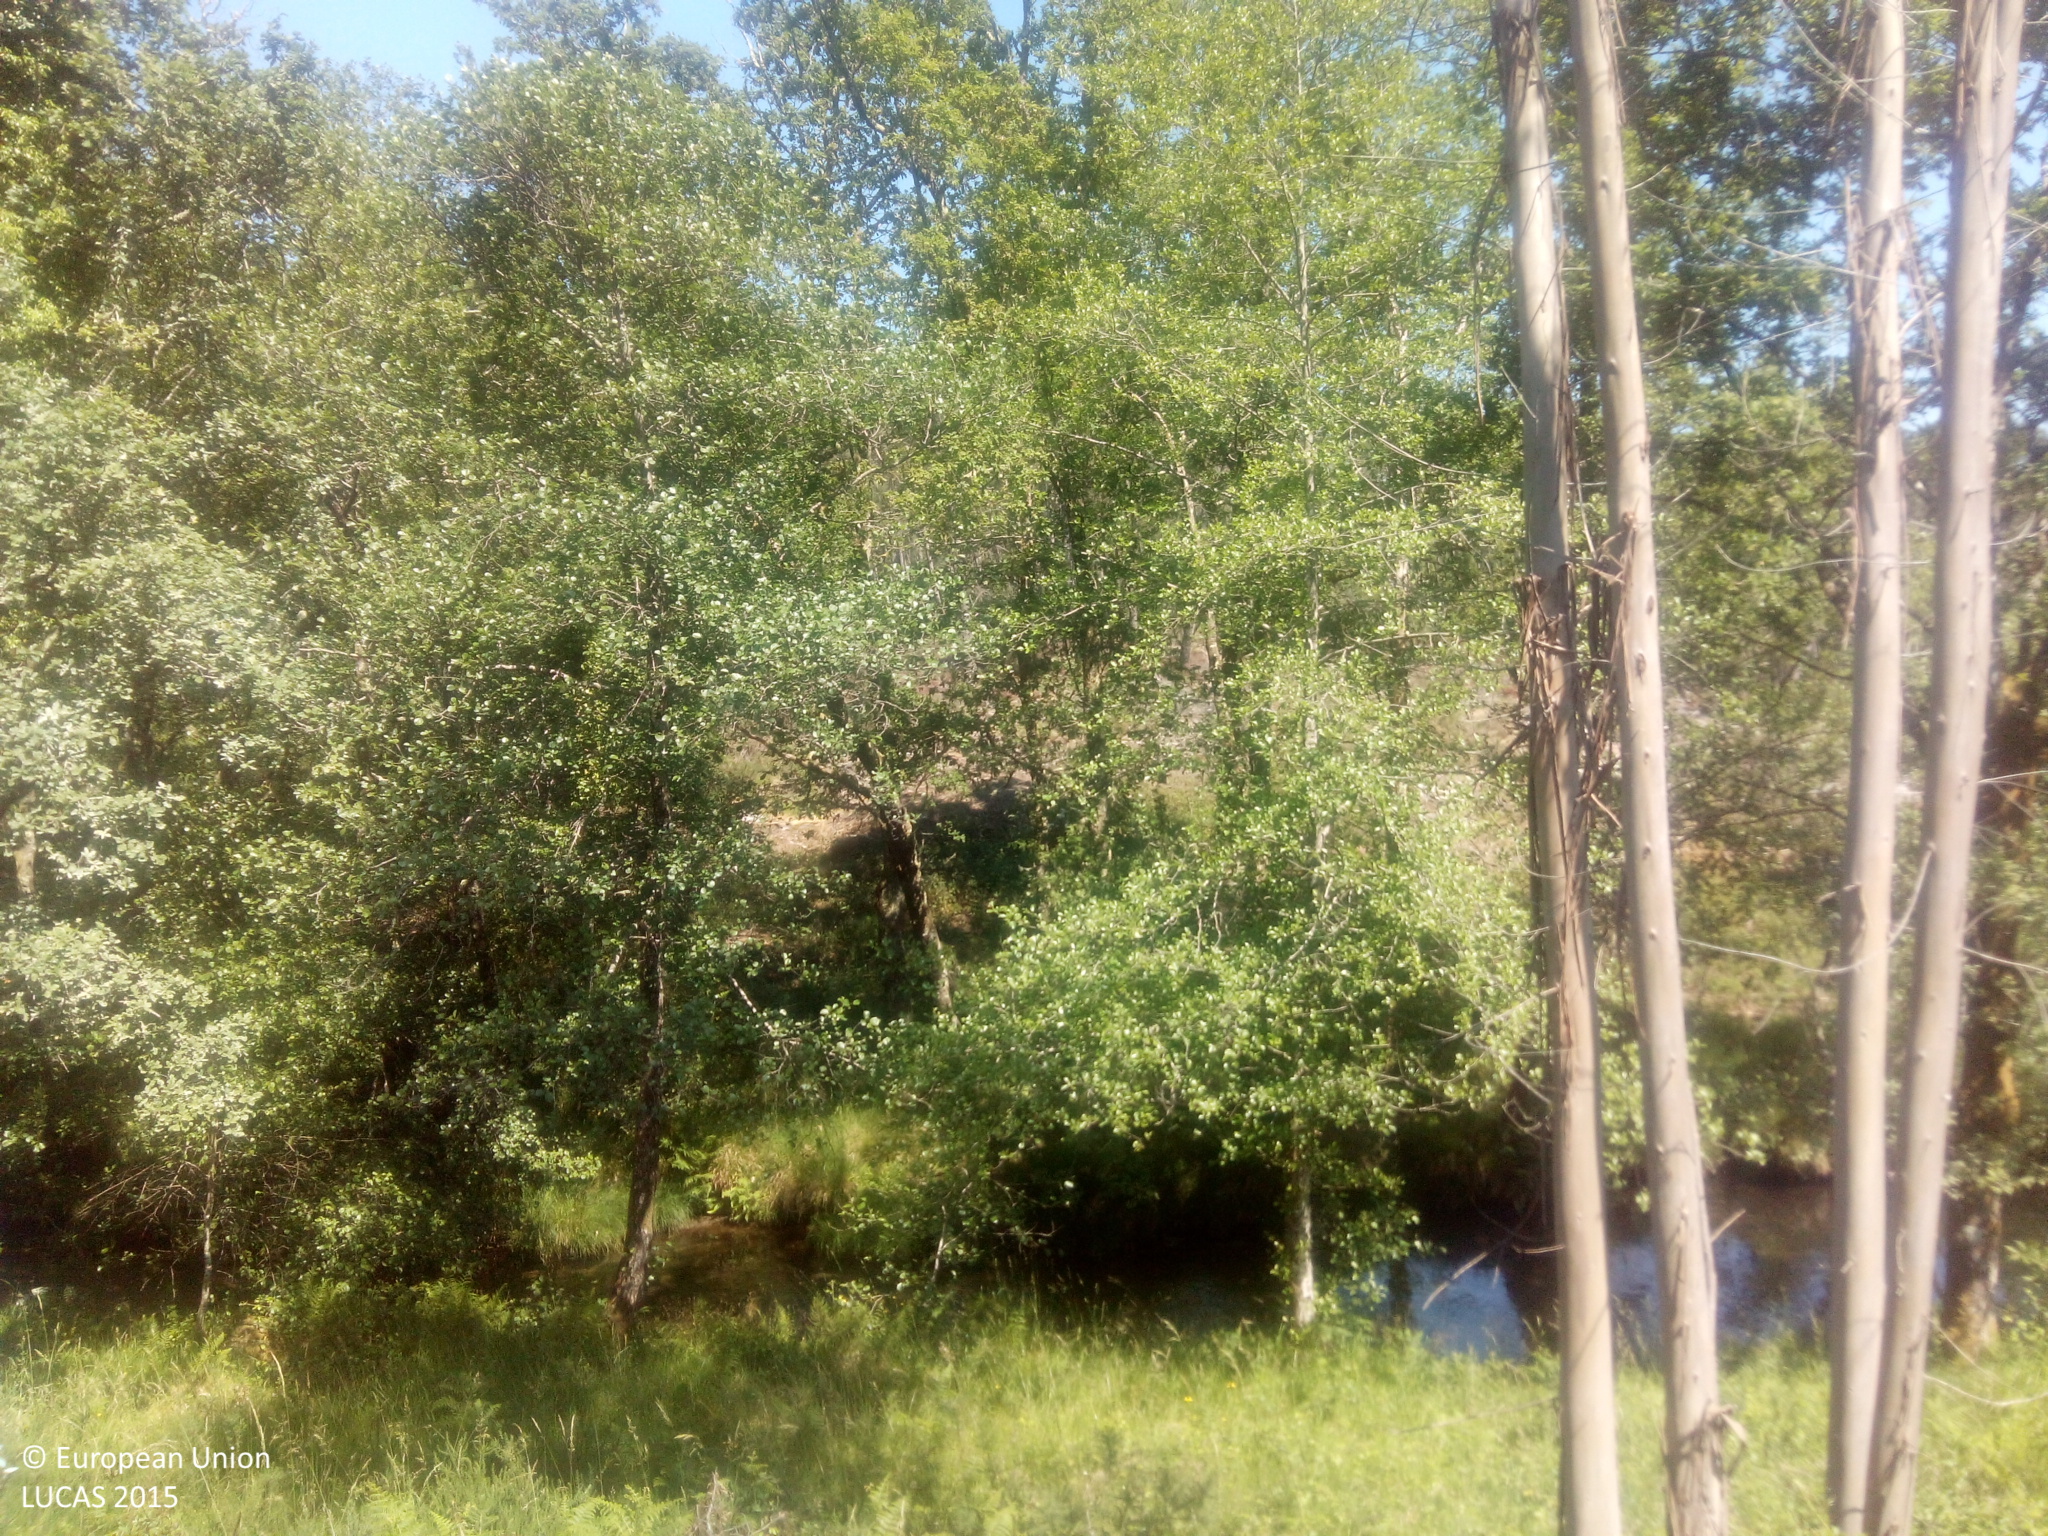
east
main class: Woodland
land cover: Pine dominated coniferous woodland
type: exotic forest
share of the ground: > 75 %
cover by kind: coniferous forest trees 75 %, shrubs 25 %
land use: Forestry
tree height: > 5 m
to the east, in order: Pine dominated coniferous woodland; Broadleaved woodland; Inland fresh water bodies; Pine dominated coniferous woodland; Tracks; Pine dominated coniferous woodland; Dry stone walls; Broadleaved woodland
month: June
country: ES
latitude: 42.2087
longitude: -8.2928
